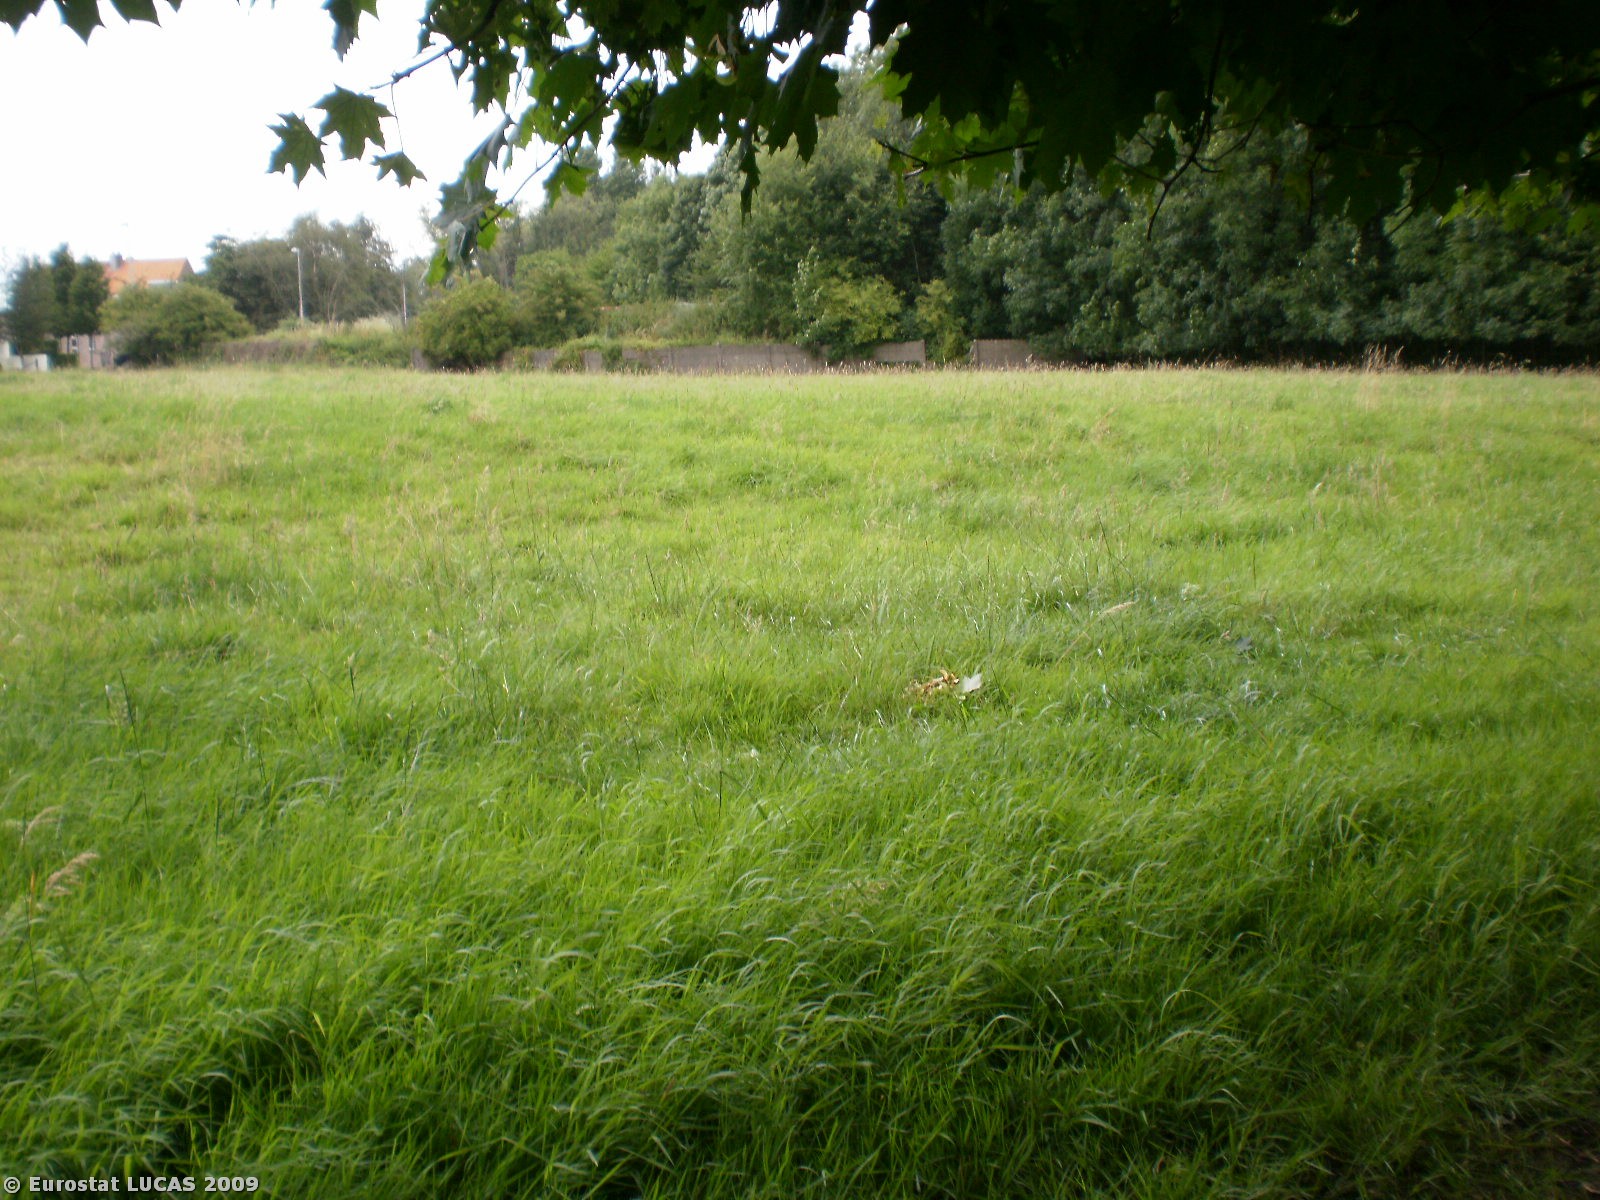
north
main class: Grassland
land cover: Grassland without tree/shrub cover
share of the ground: > 75 %
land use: Agriculture (excluding fallow land and kitchen gardens)
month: July
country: BE
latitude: 50.8693
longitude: 4.2685
